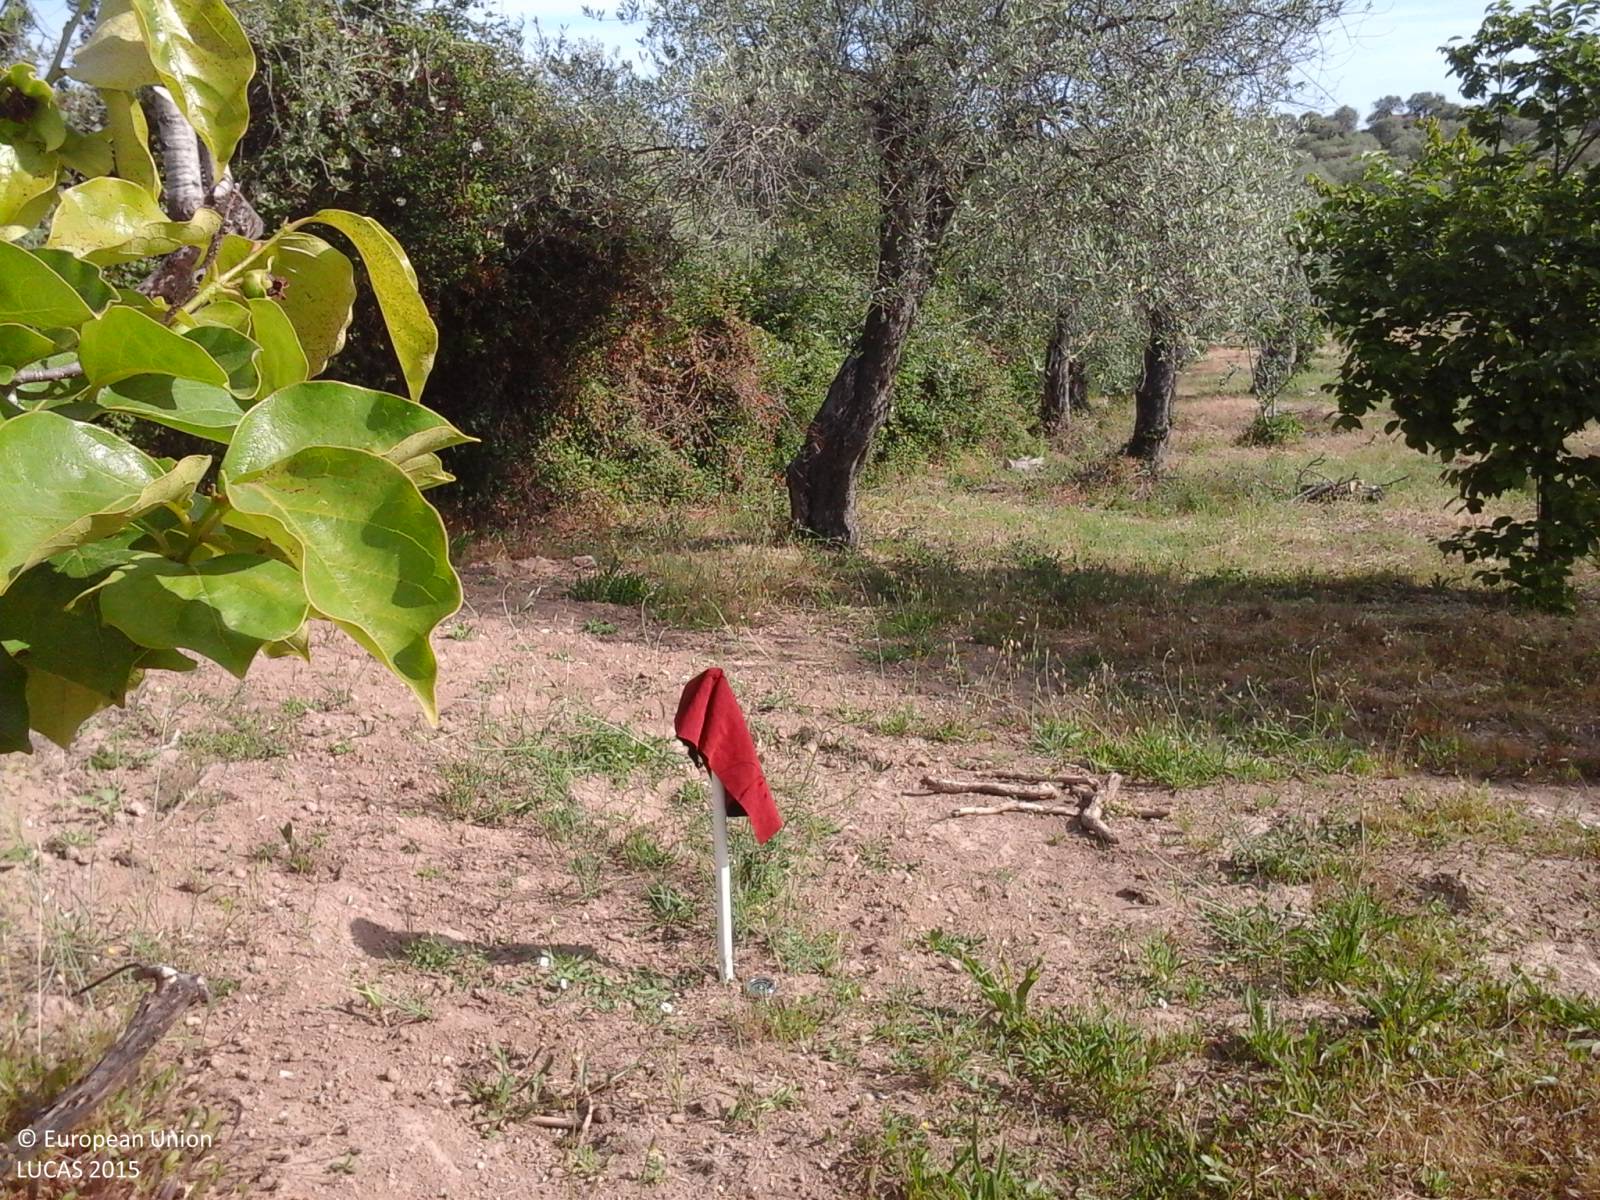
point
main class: Cropland
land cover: Olive groves
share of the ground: > 75 %
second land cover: Grassland without tree/shrub cover
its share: > 75 %
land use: Agriculture (excluding fallow land and kitchen gardens)
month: May
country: IT
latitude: 40.7638
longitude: 8.5734
